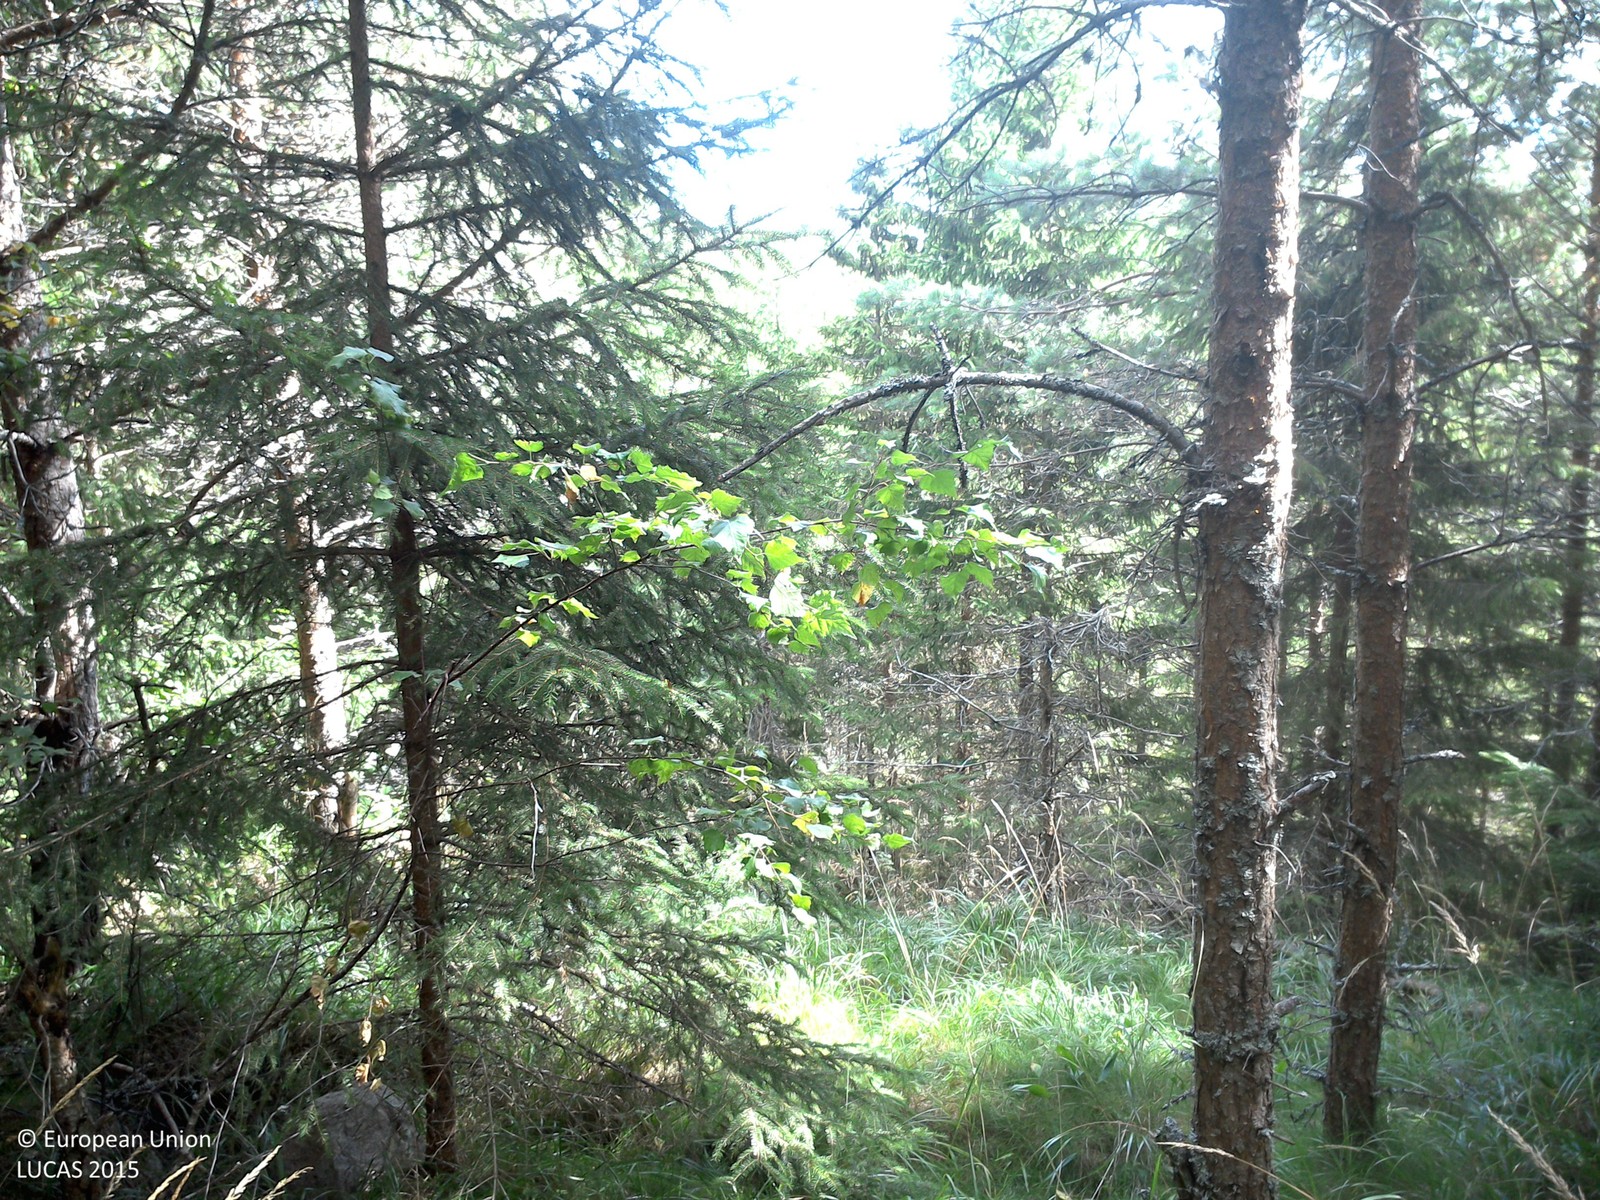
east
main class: Woodland
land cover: Pine dominated mixed woodland
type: boreal forest
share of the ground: 50 - 75 %
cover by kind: coniferous forest trees 50 %, broadleaved forest trees 20 %, herbaceous plants 20 %, lichens and mosses 10 %
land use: Forestry
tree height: > 5 m
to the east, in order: Pine dominated mixed woodland; Spruce dominated coniferous woodland; Pine dominated coniferous woodland
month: August
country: SE
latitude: 57.9053
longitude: 15.5814
